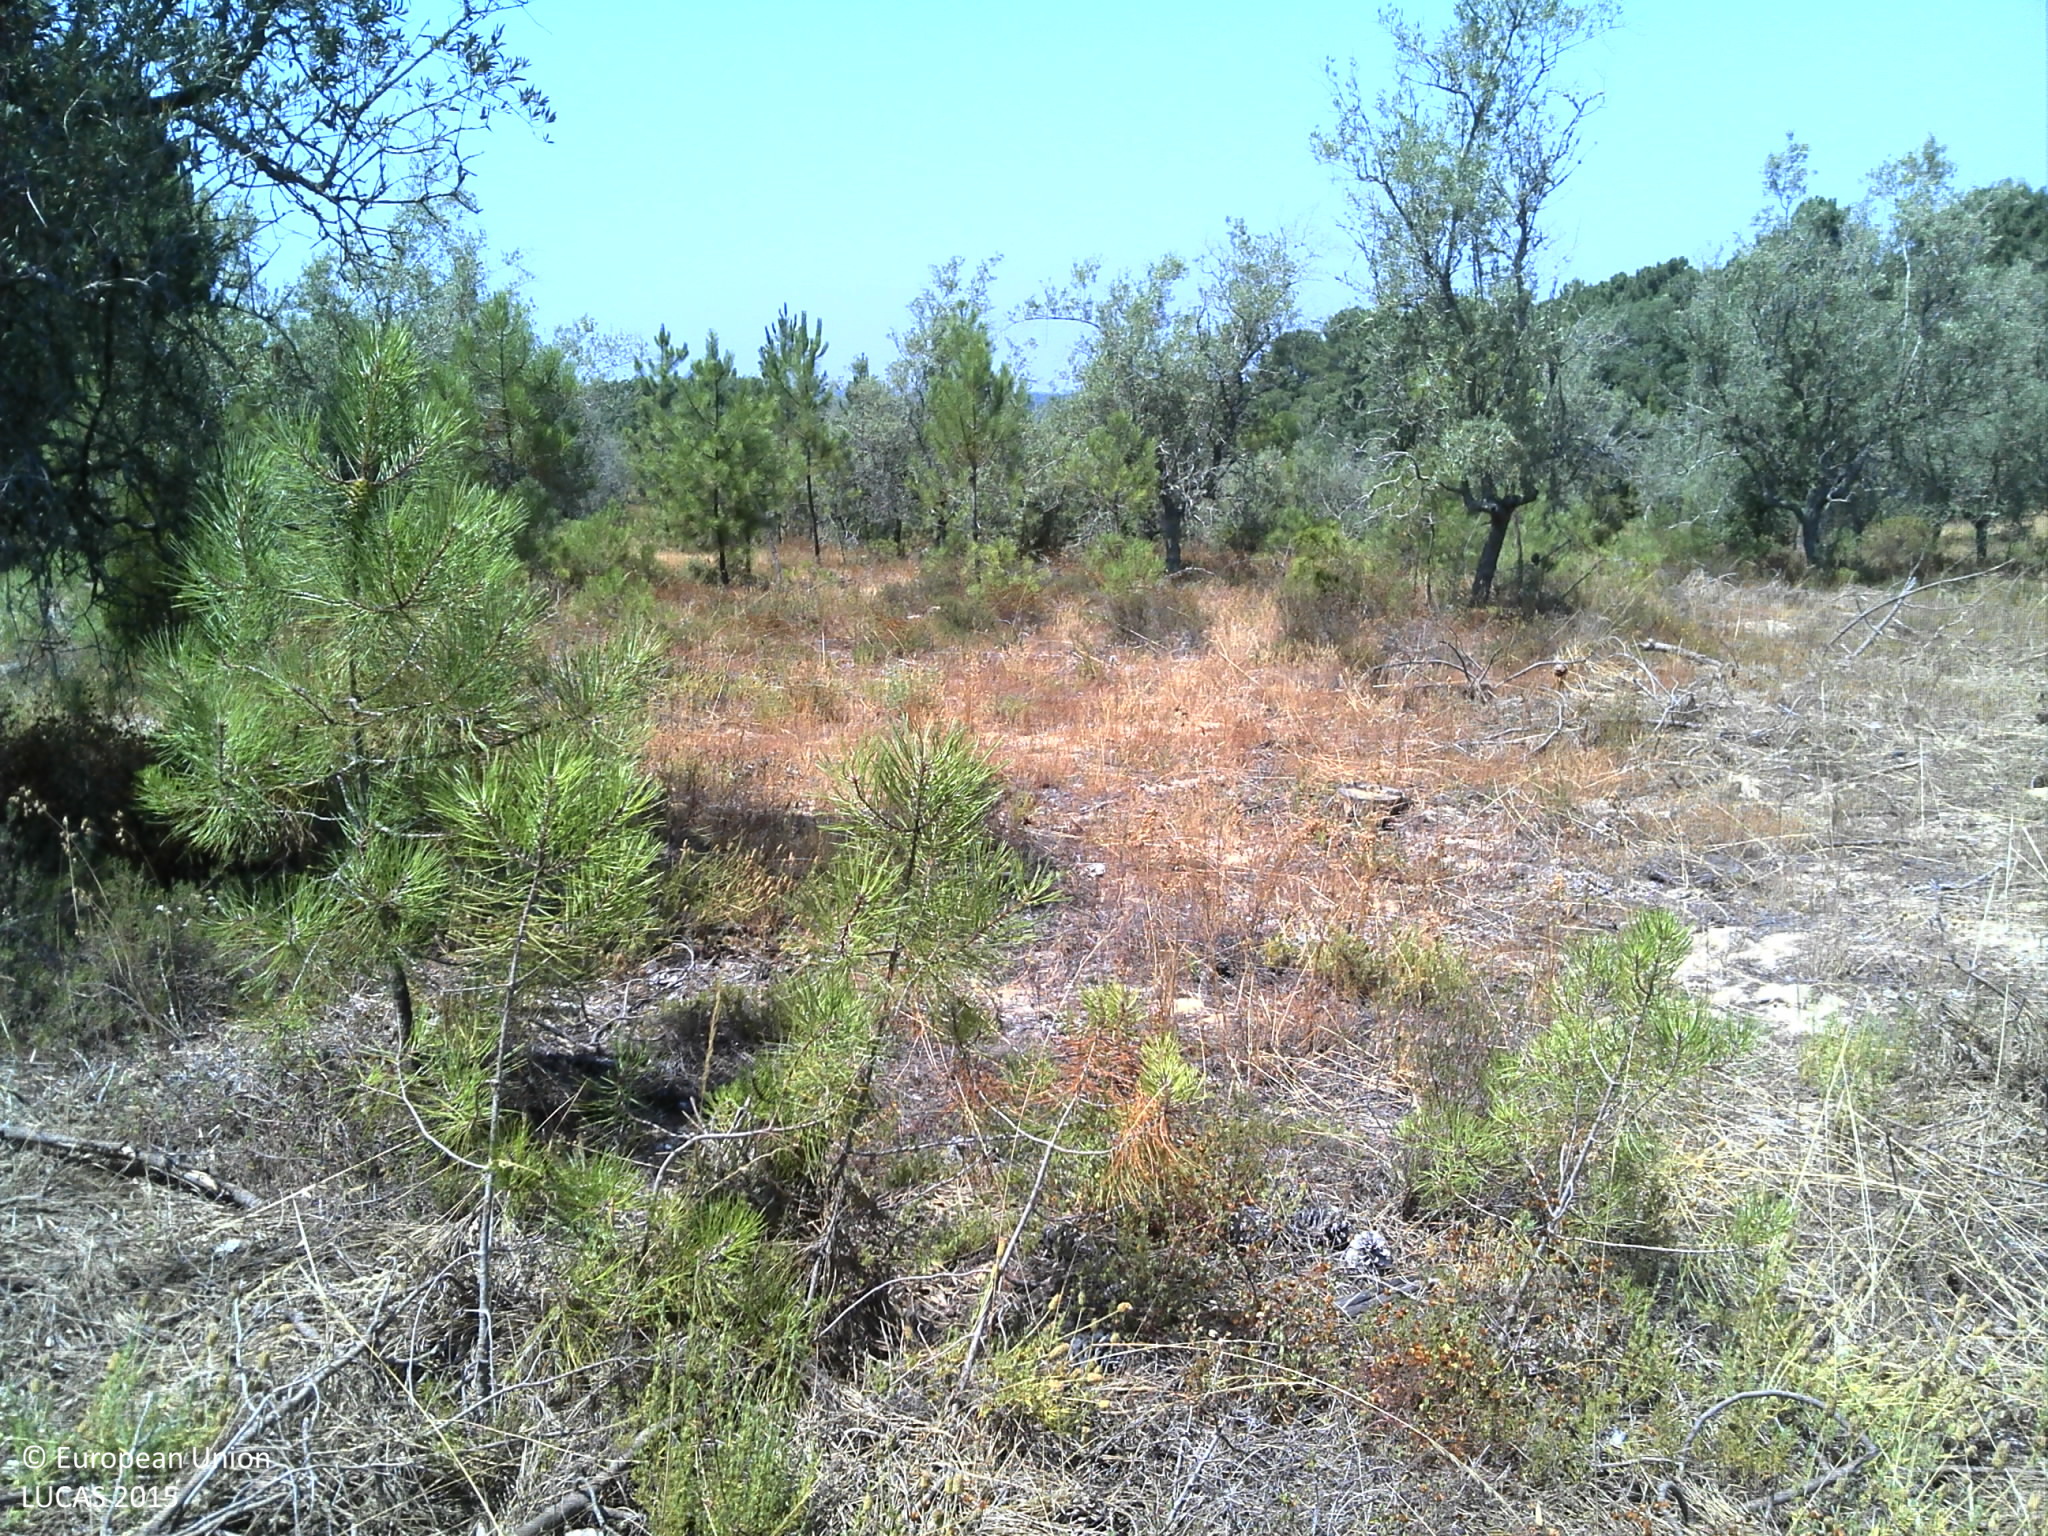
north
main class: Woodland
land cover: Pine dominated coniferous woodland
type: coniferous forest of the mediterranean region
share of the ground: 25 - 50 %
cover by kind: coniferous forest trees 35 %, unconsolidated bare surface 30 %, shrubs 15 %, herbaceous plants 15 %, broadleaved forest trees 5 %
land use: Forestry
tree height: > 5 m
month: June
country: PT
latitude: 38.4892
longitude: -9.0652
